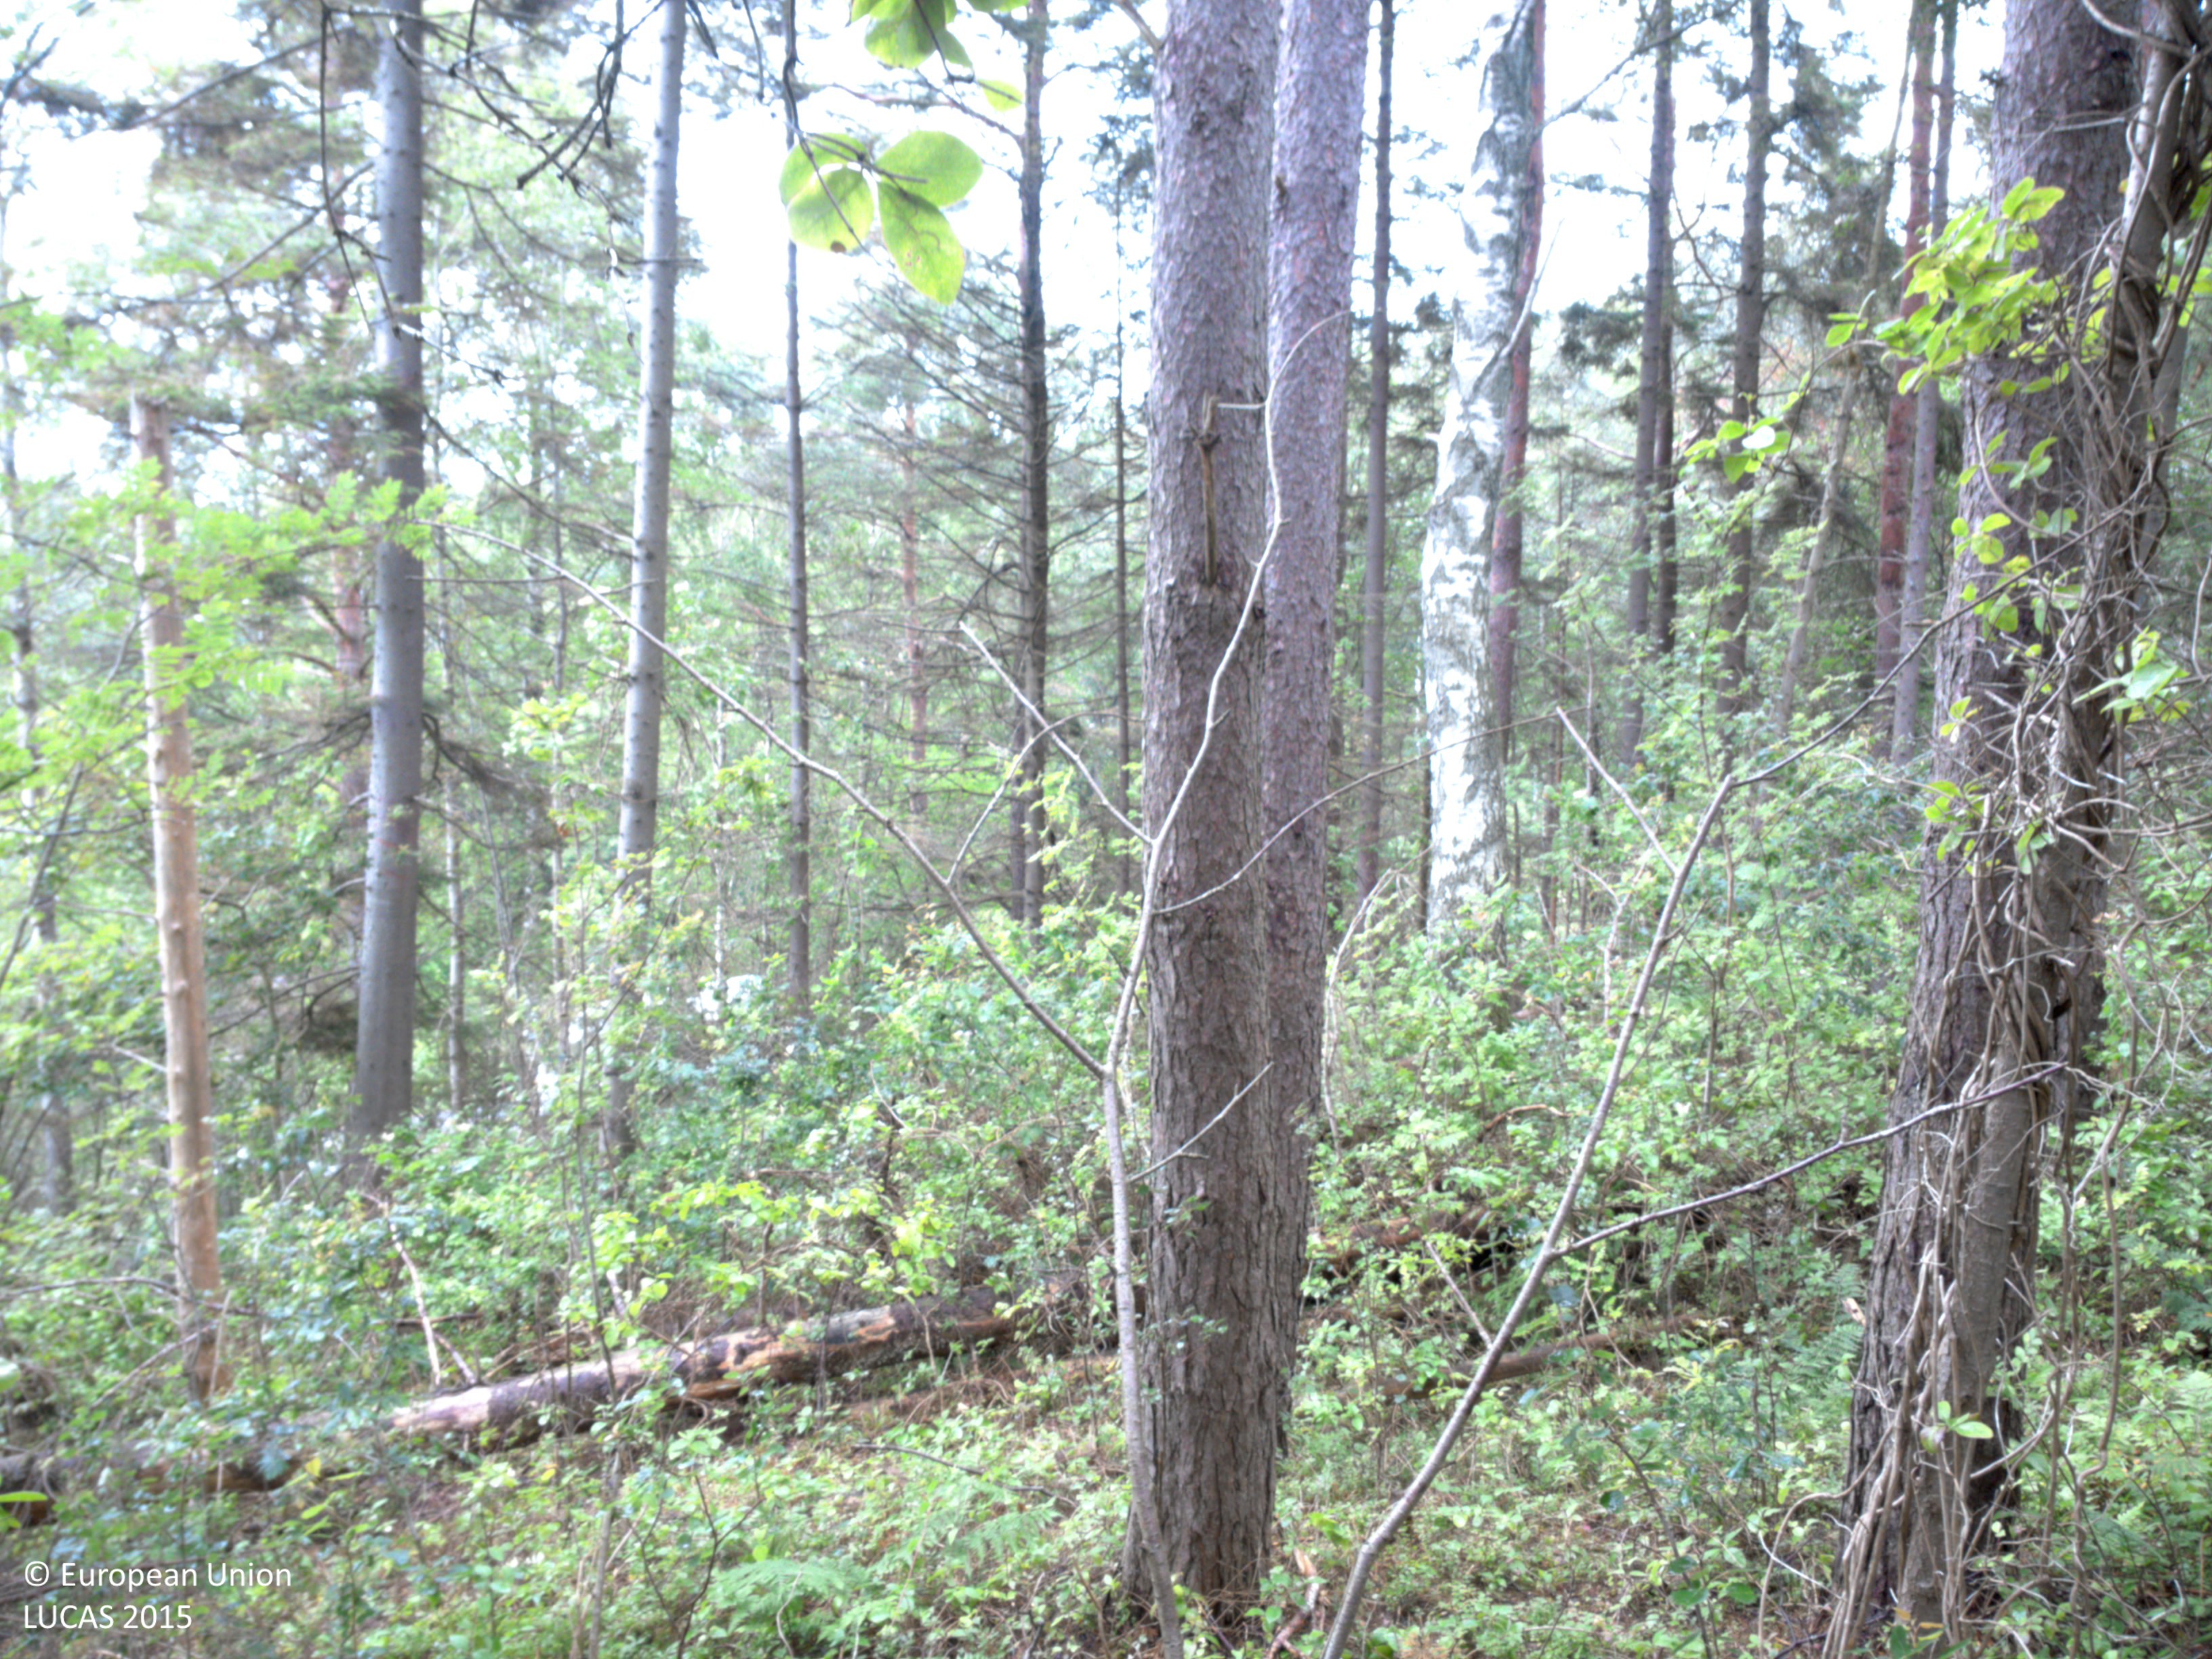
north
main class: Woodland
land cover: Pine dominated mixed woodland
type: boreal forest
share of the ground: 50 - 75 %
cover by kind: coniferous forest trees 35 %, broadleaved forest trees 25 %, herbaceous plants 20 %, consolidated bare surface 20 %
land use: Semi-natural and natural areas not in use
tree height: > 5 m
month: July
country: SE
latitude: 58.0643
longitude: 11.7425
